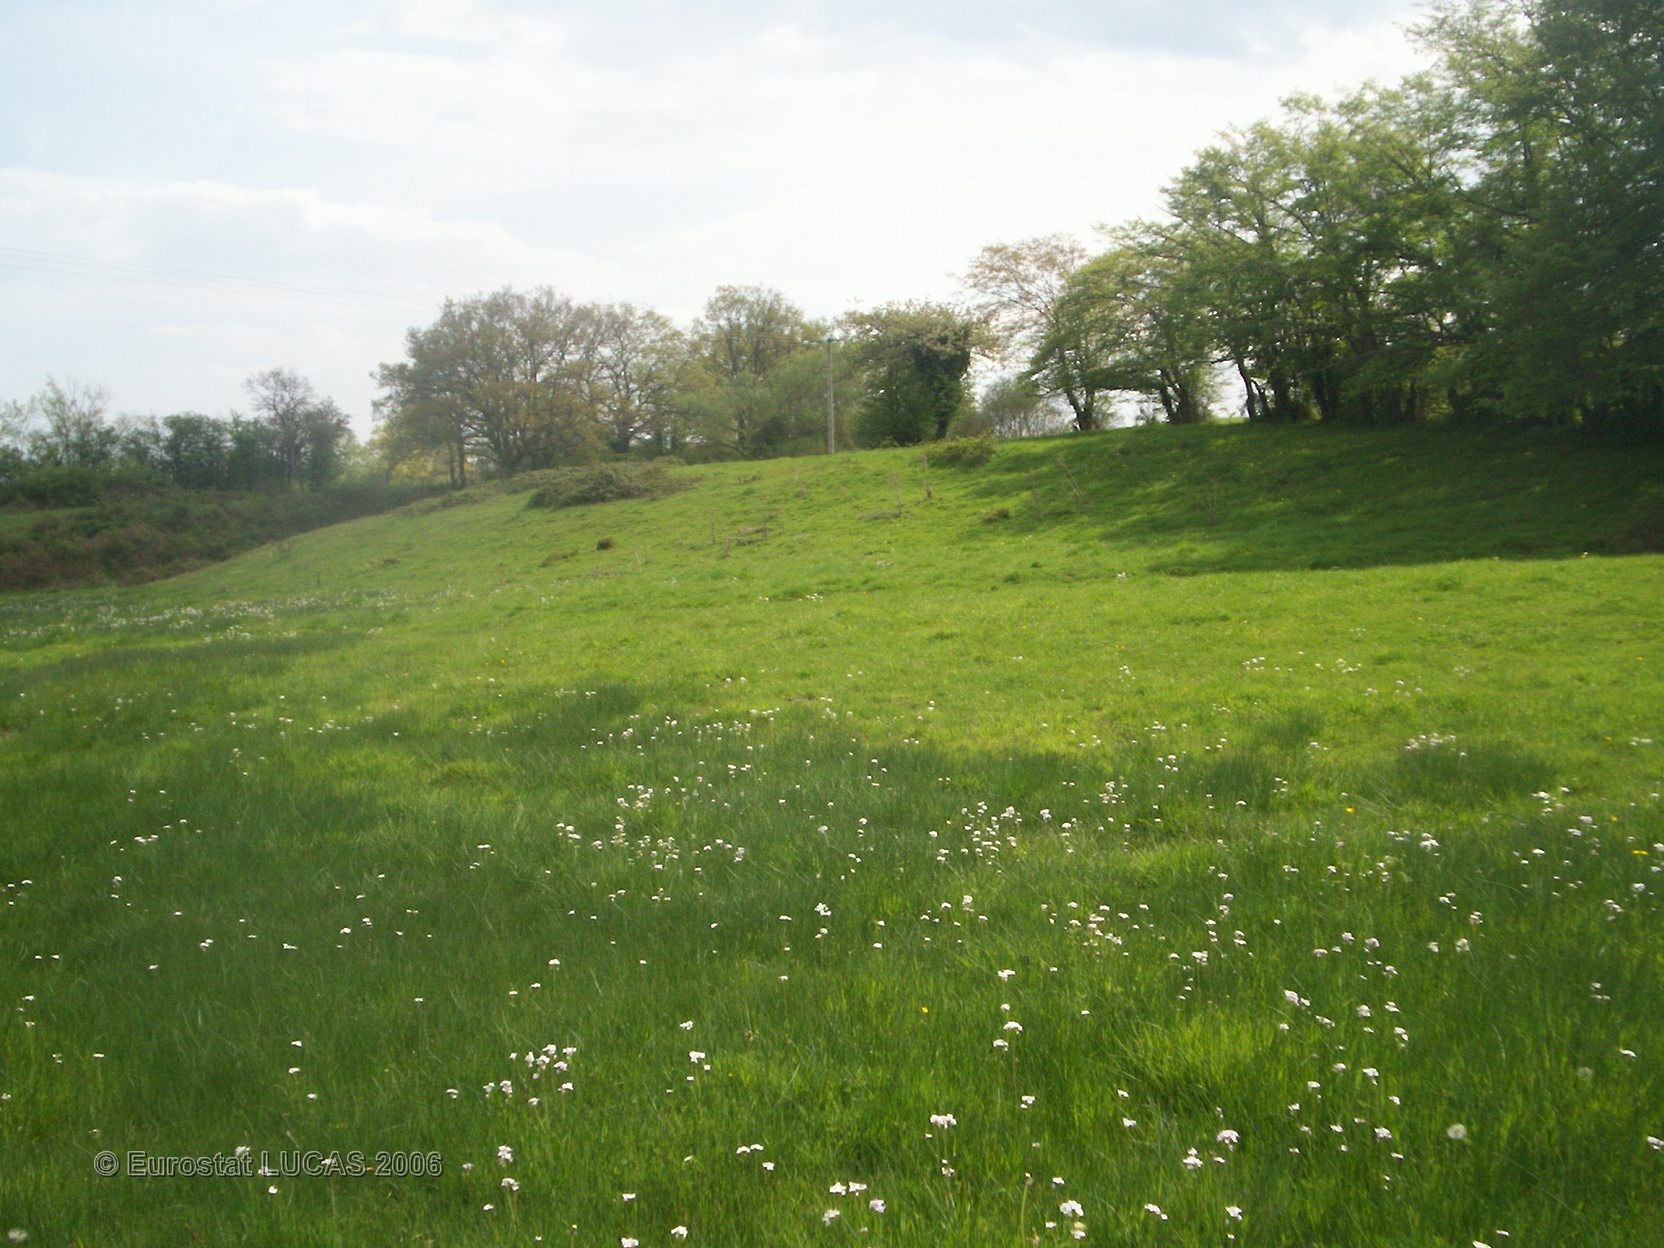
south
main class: Grassland
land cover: Grassland without tree/shrub cover
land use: Agriculture (excluding fallow land and kitchen gardens)
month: May
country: FR
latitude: 46.4022
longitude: 3.1433
